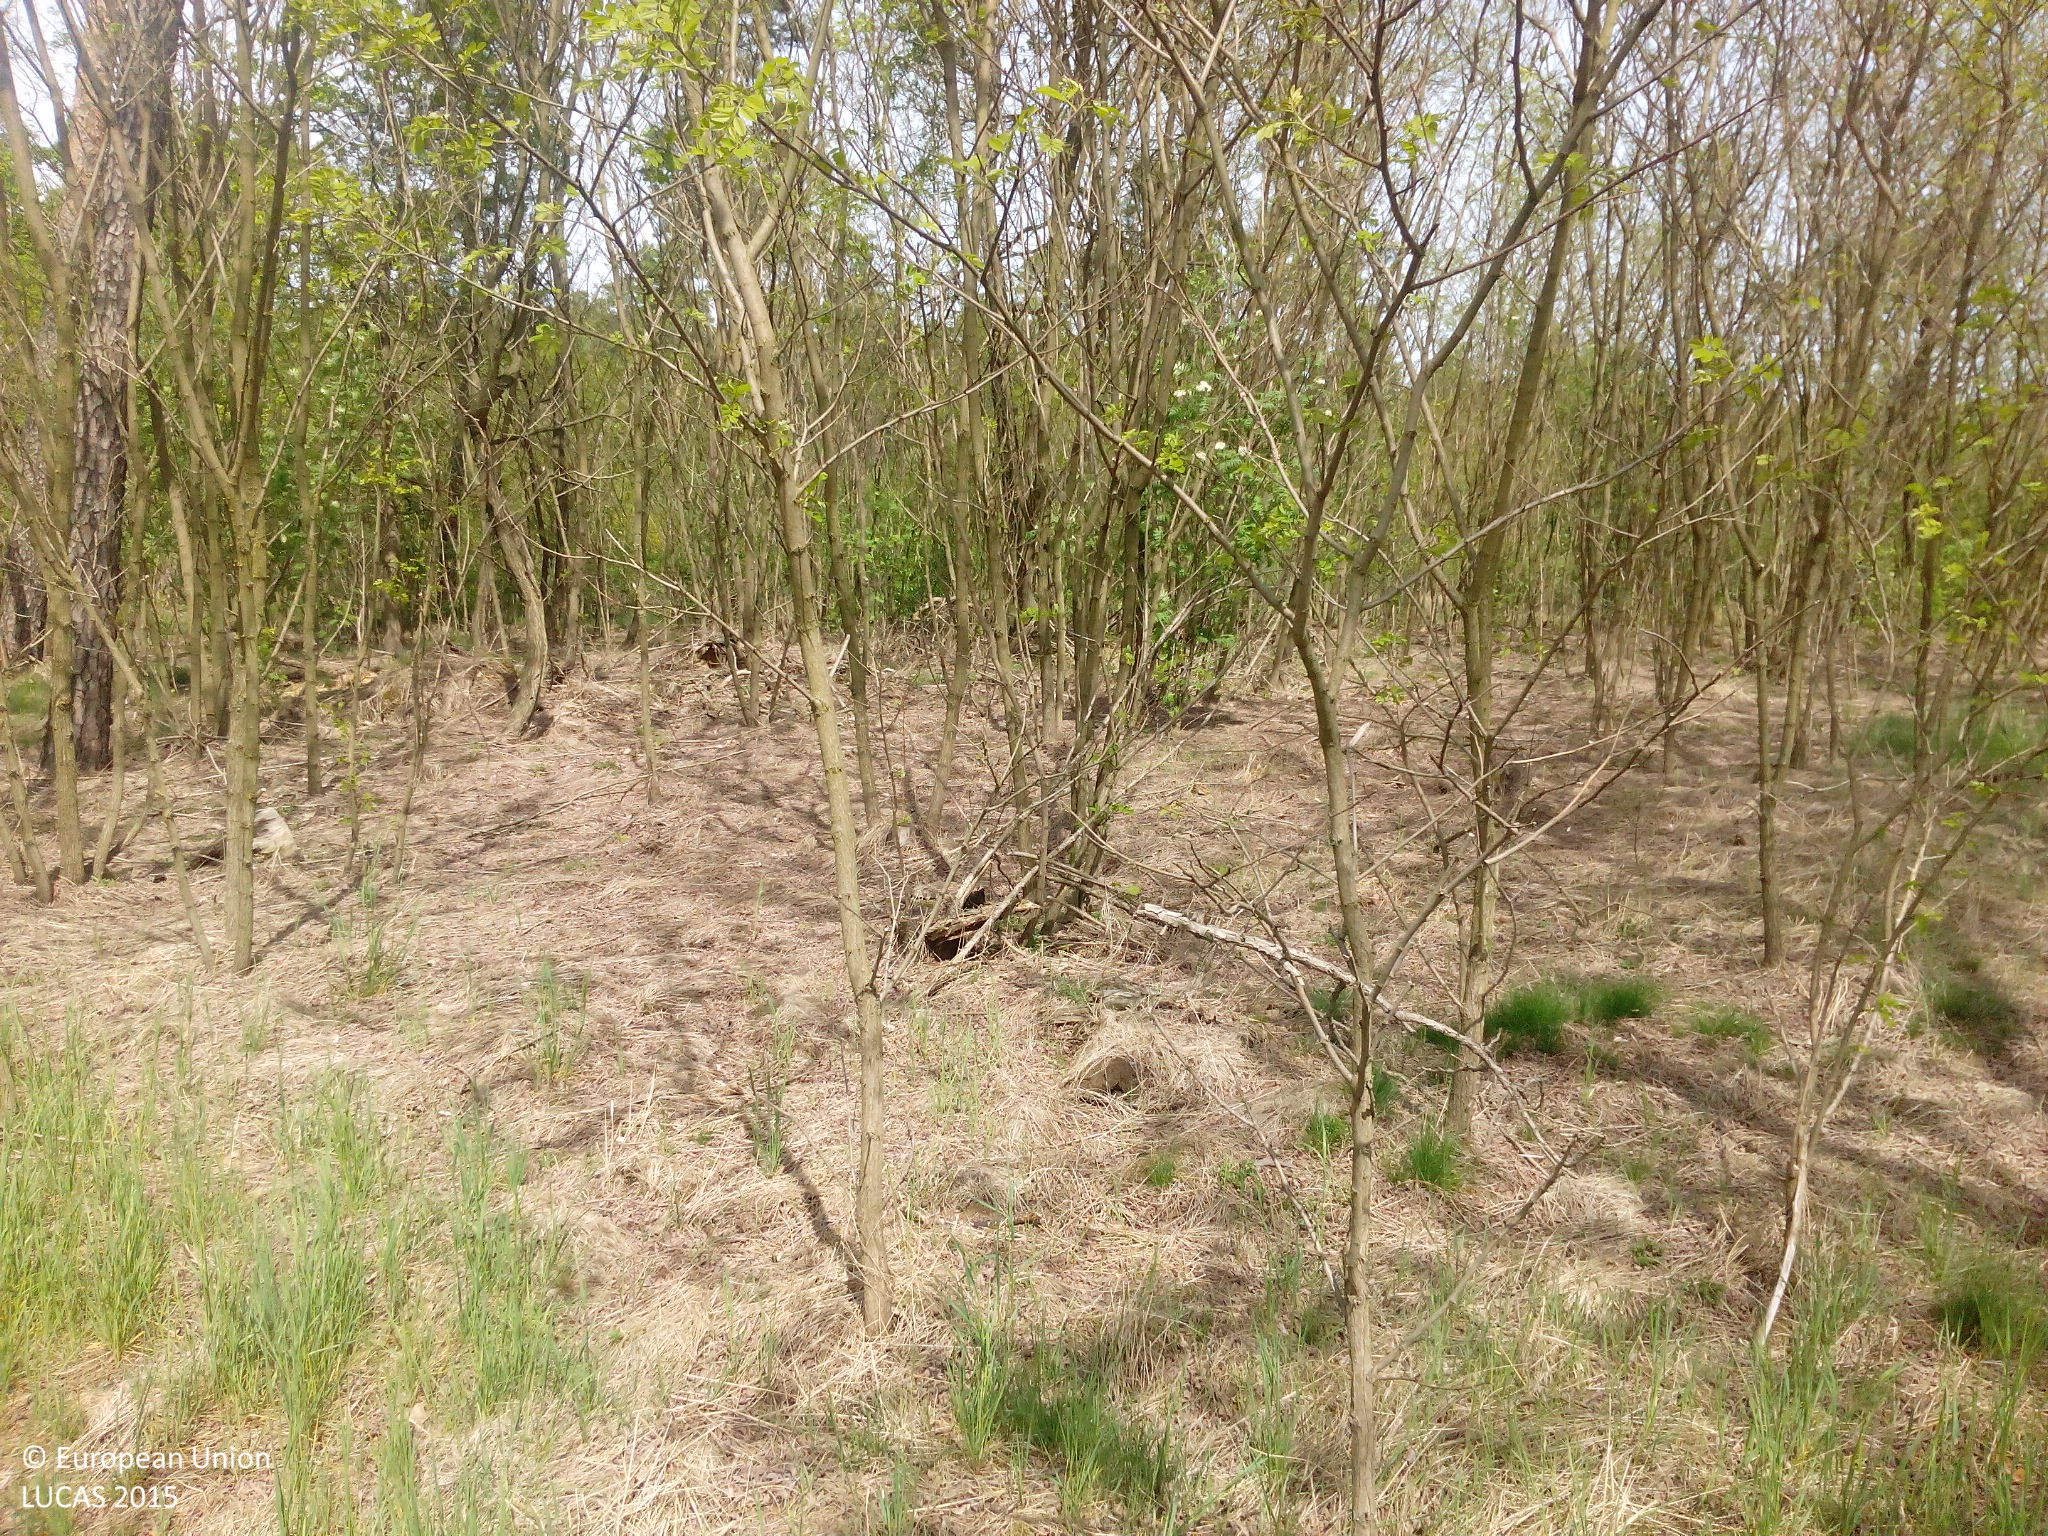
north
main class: Woodland
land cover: Broadleaved woodland
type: mesophytic deciduous forest
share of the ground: > 75 %
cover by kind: broadleaved forest trees 90 %, coniferous forest trees 10 %
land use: Forestry
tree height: > 5 m
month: May
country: DE
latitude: 51.9282
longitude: 13.5633
